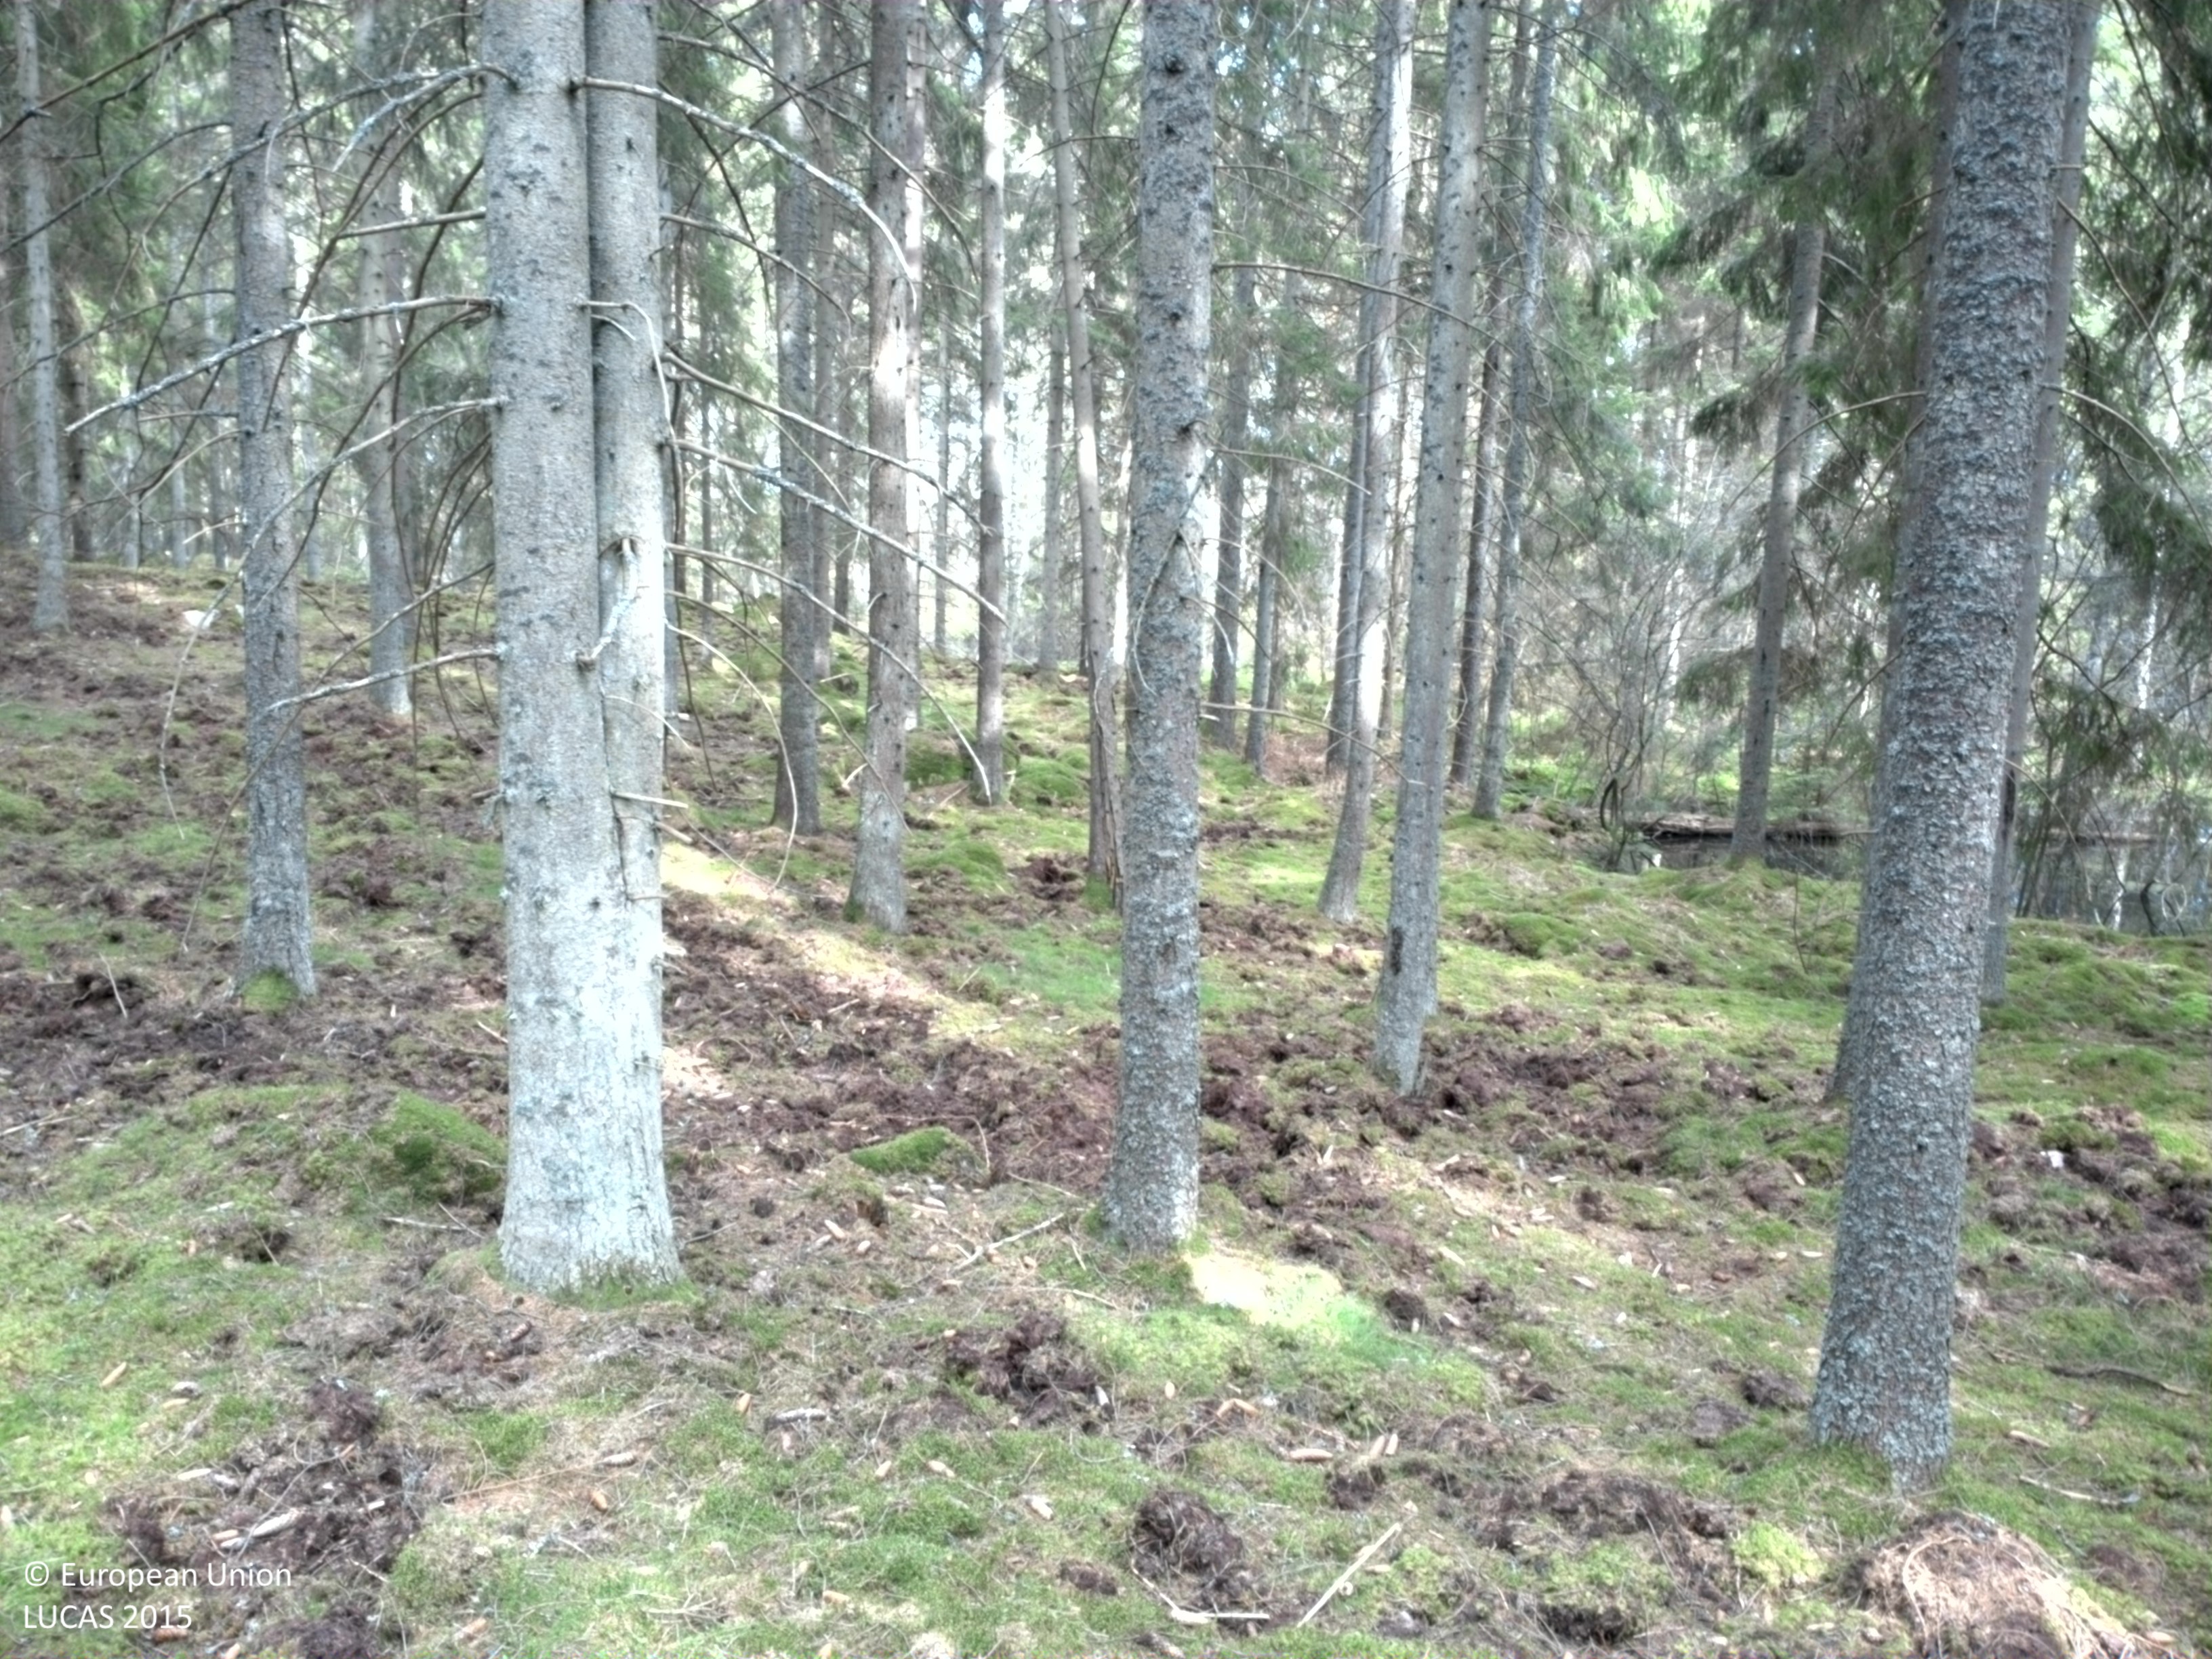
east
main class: Woodland
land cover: Spruce dominated coniferous woodland
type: boreal forest
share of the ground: > 75 %
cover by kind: coniferous forest trees 90 %, lichens and mosses 10 %
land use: Forestry
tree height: > 5 m
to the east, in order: Spruce dominated coniferous woodland; Paved roads, cycling and walking lanes; Other structural elements; Other bare soil; Broadleaved woodland; Inland fresh running water; Broadleaved woodland
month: May
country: SE
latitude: 56.4343
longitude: 15.8219
